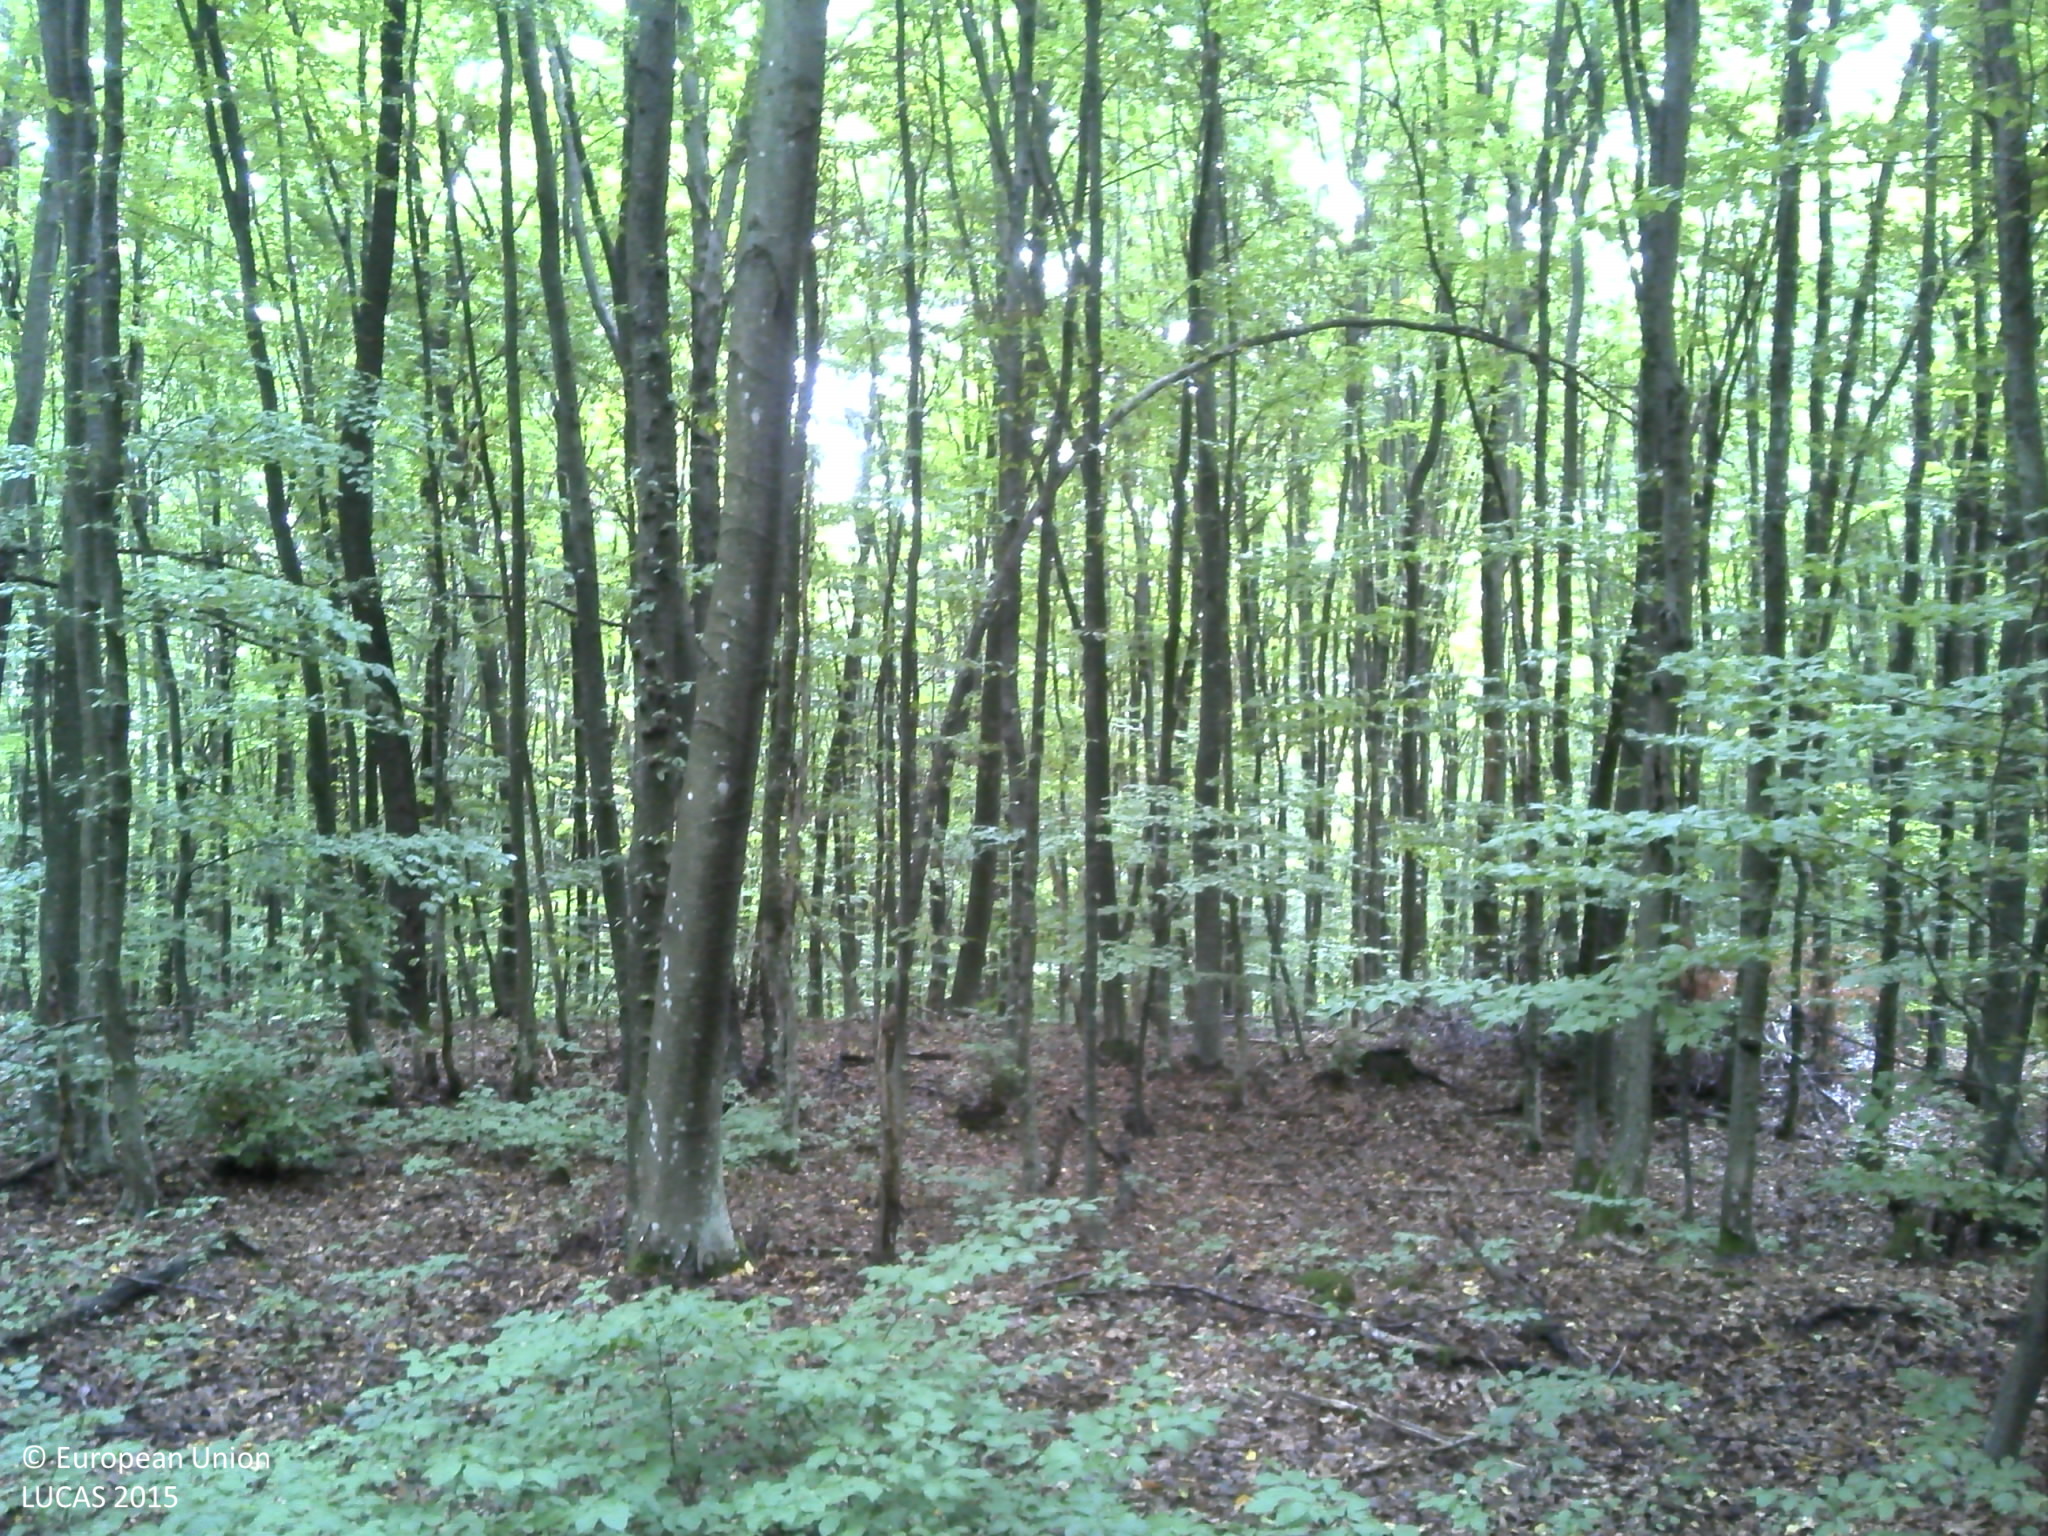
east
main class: Woodland
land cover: Broadleaved woodland
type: beech forest
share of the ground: > 75 %
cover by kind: broadleaved forest trees 100 %
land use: Forestry
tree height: > 5 m
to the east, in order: Broadleaved woodland
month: August
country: HR
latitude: 45.4056
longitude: 15.6817
